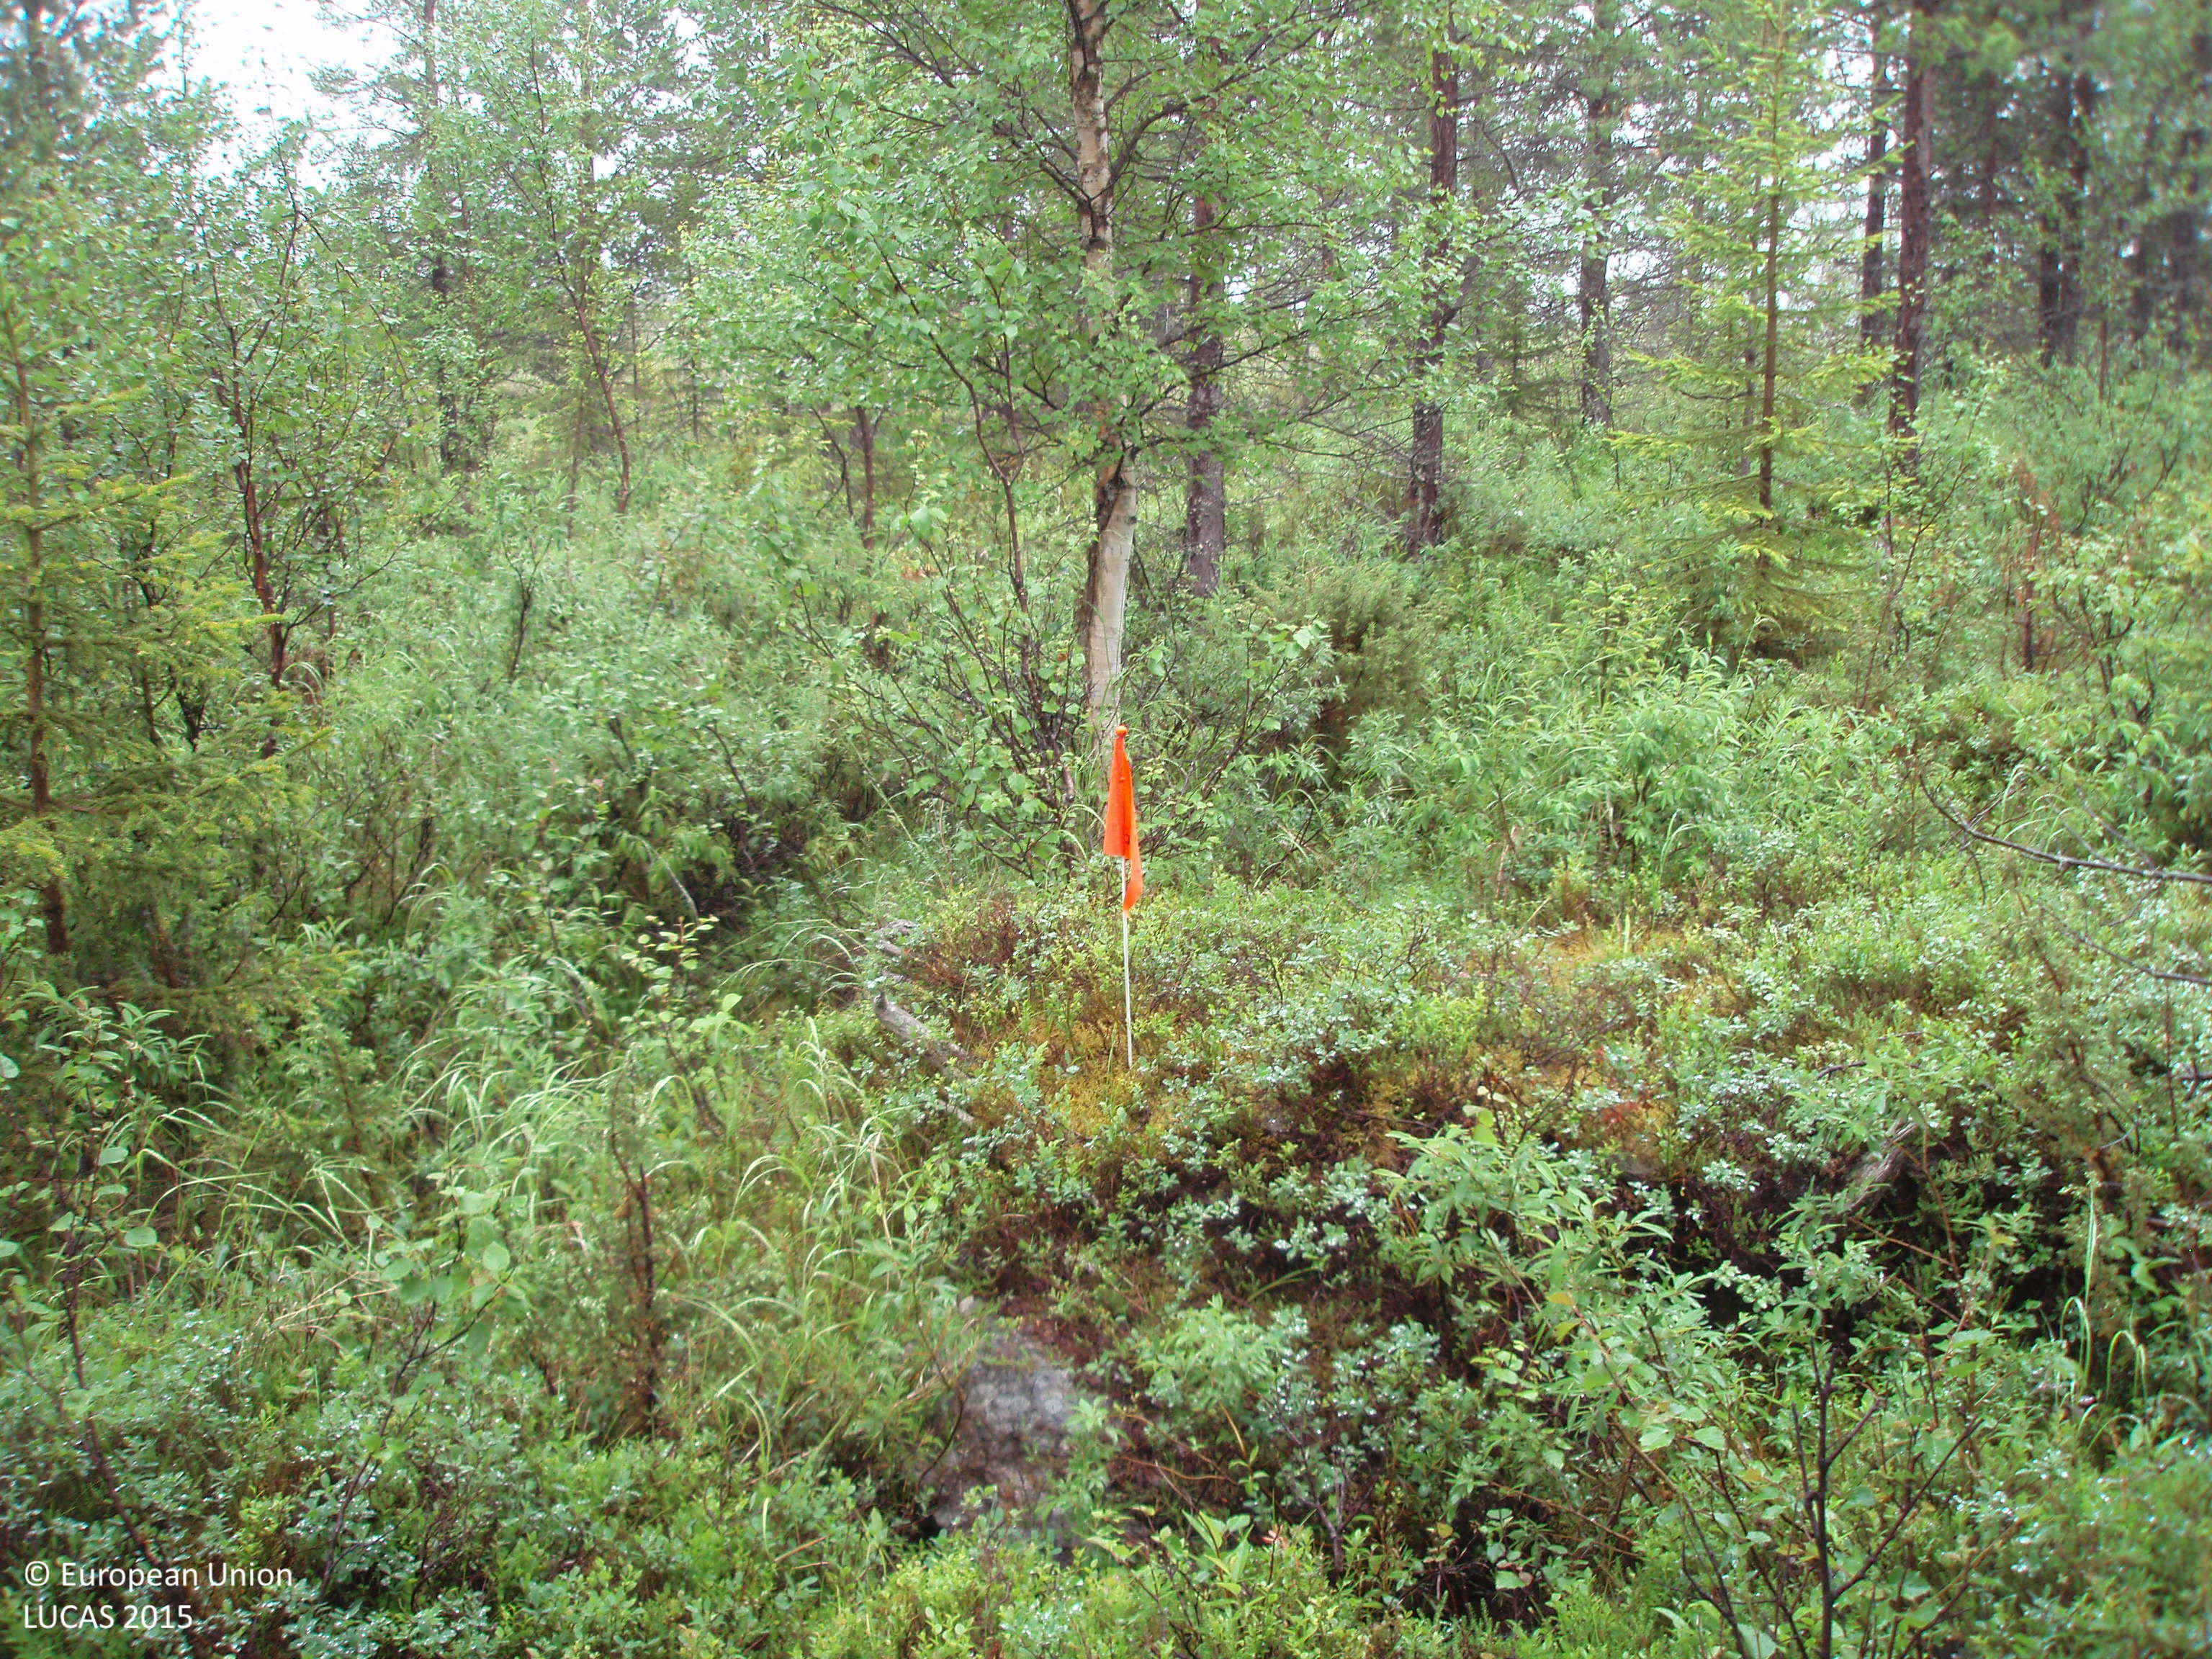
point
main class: Woodland
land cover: Pine dominated coniferous woodland
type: boreal forest
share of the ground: > 75 %
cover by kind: coniferous forest trees 65 %, shrubs 25 %, broadleaved forest trees 10 %
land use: Semi-natural and natural areas not in use
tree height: > 5 m
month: July
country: FI
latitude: 66.7446
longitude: 28.5975
